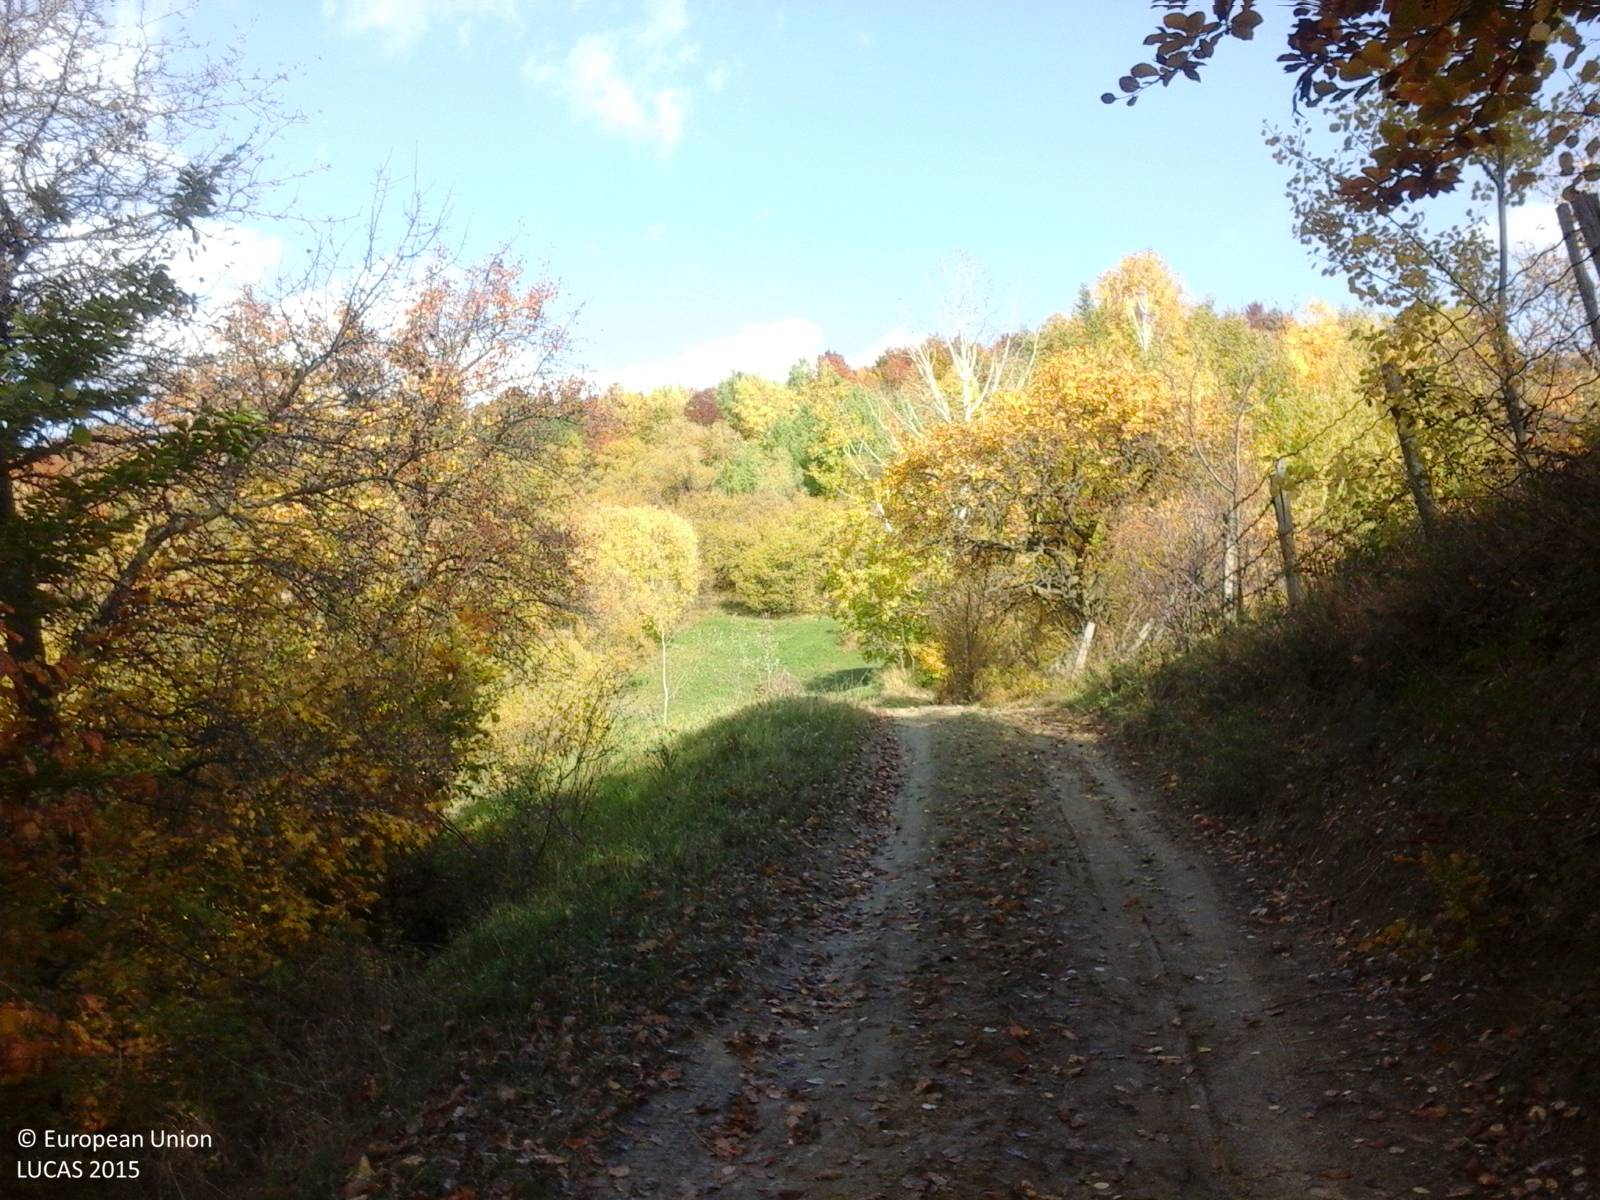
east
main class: Woodland
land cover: Broadleaved woodland
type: beech forest
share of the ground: > 75 %
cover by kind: broadleaved forest trees 100 %
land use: Forestry
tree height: > 5 m
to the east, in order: Broadleaved woodland; Permanent crops (only in case pi); Broadleaved woodland
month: October
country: RO
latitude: 45.6058
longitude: 26.8687
